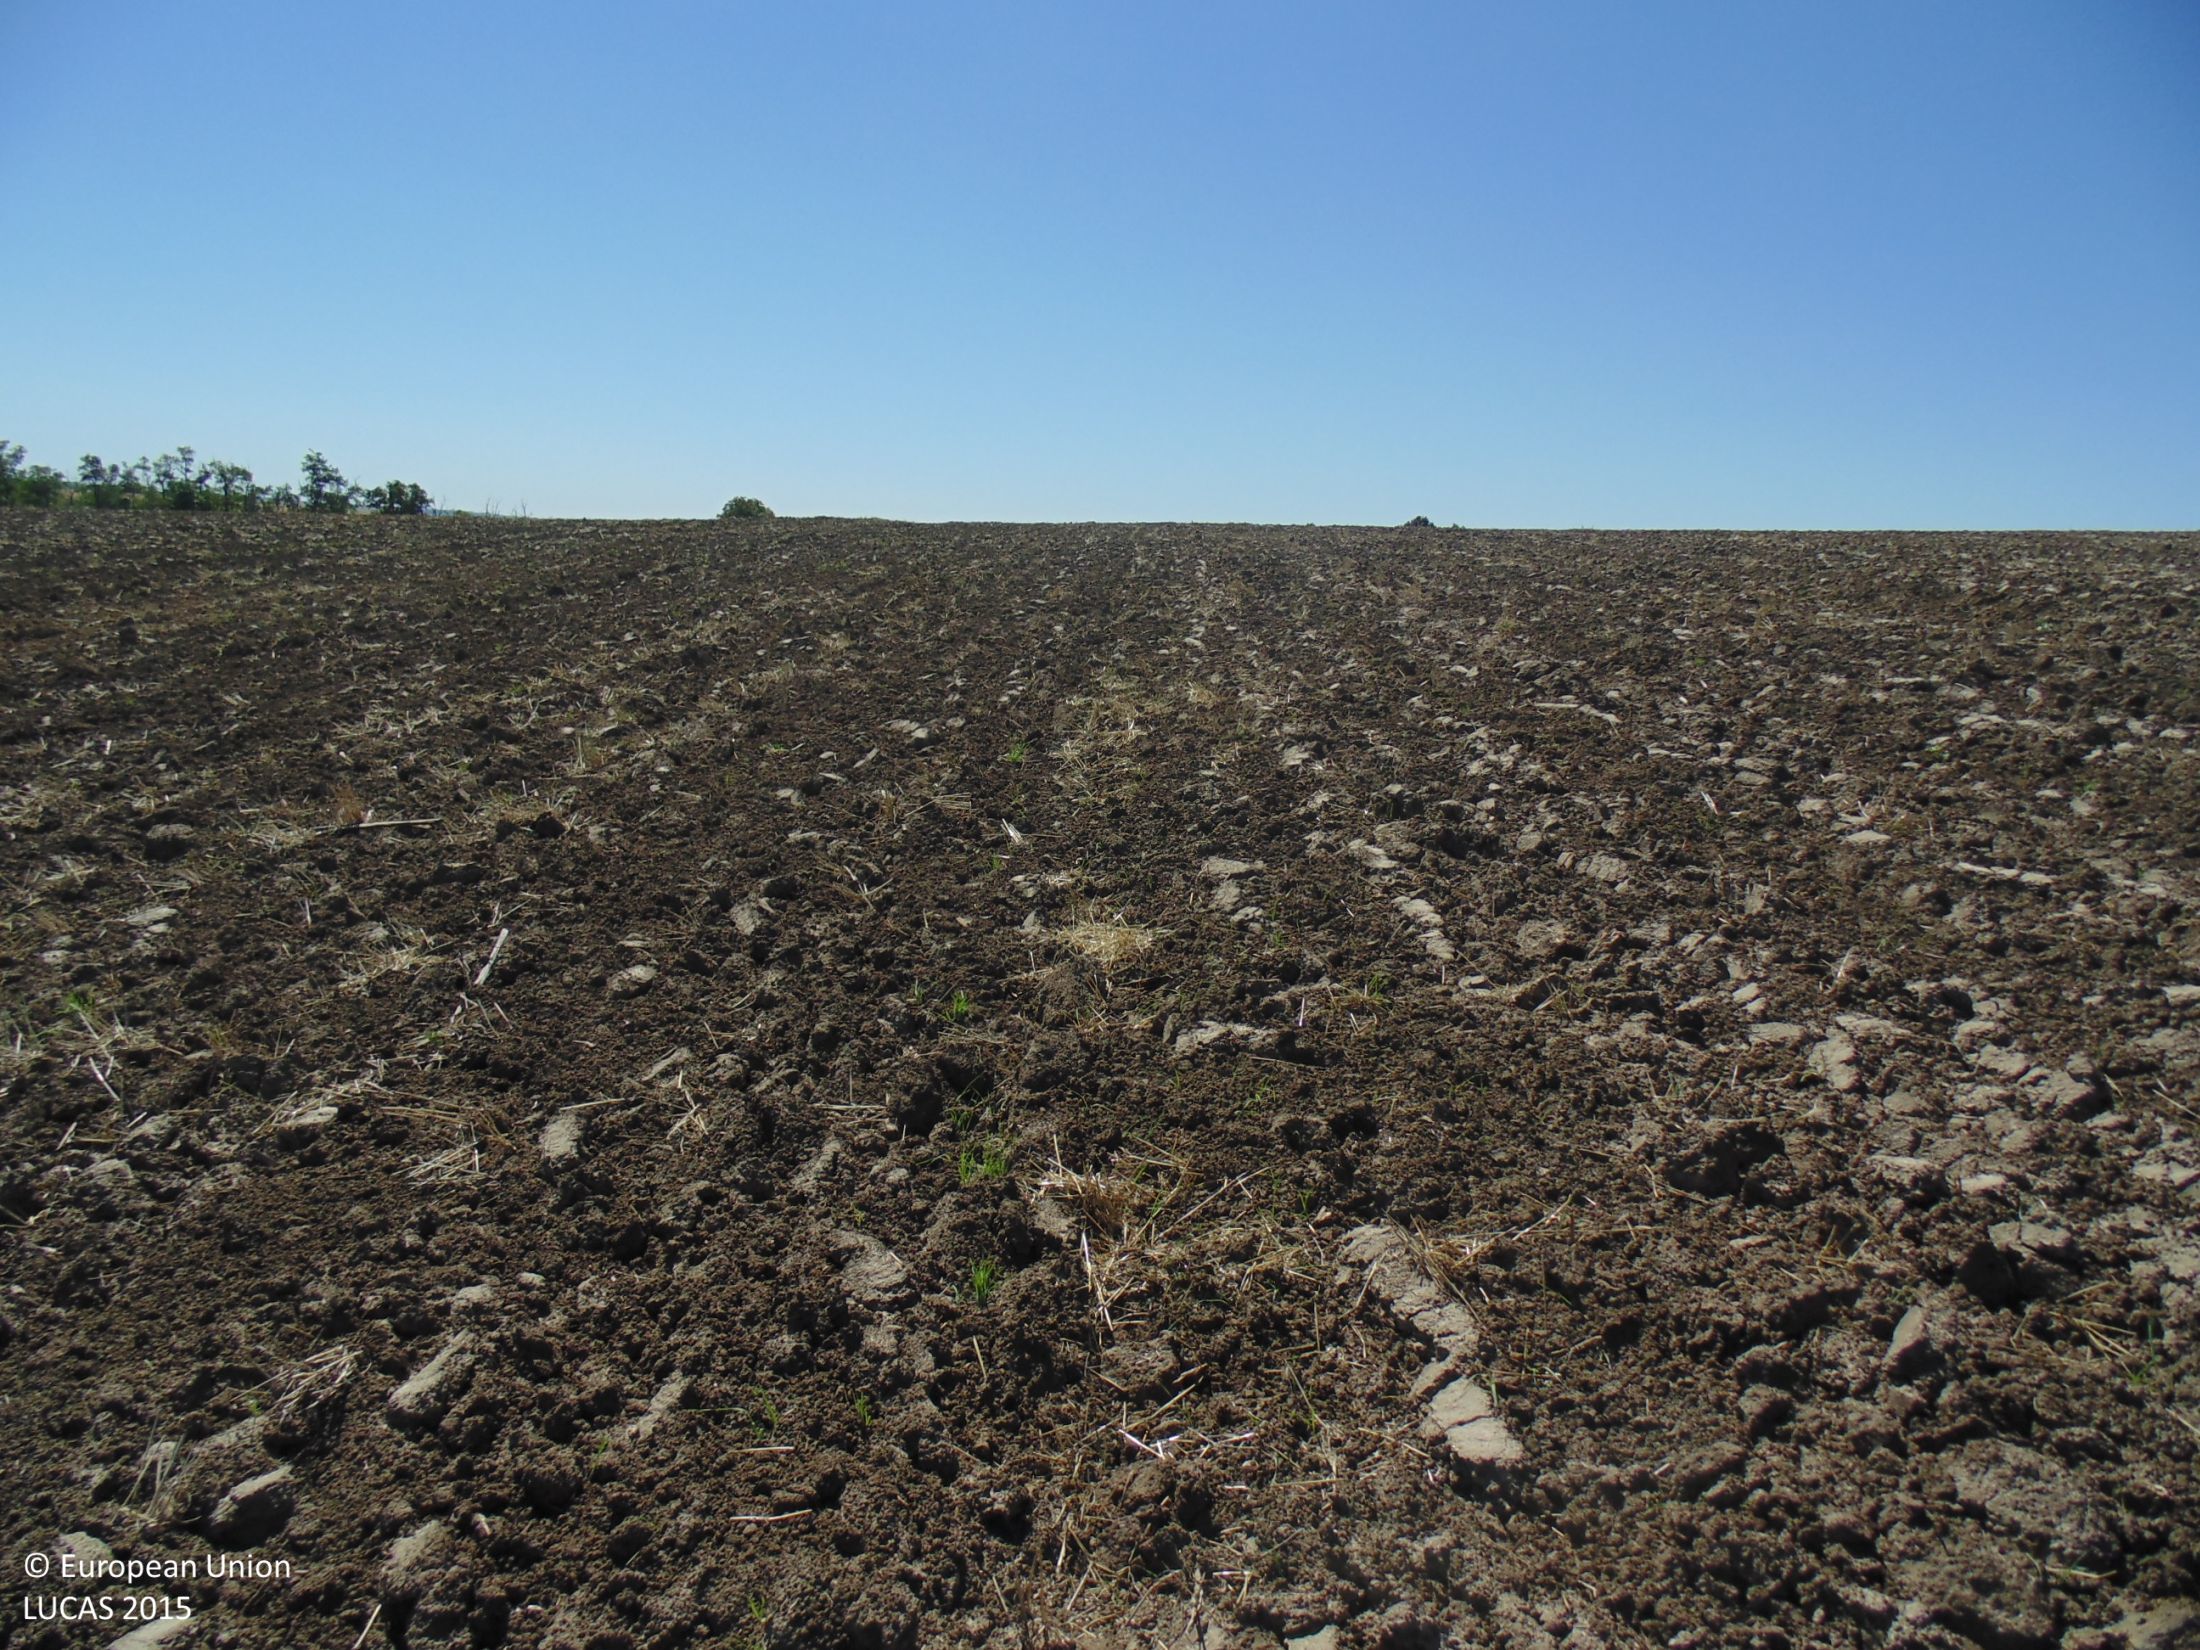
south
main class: Cropland
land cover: Common wheat
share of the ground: < 10 %
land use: Agriculture (excluding fallow land and kitchen gardens)
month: September
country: BG
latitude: 43.7580
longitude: 27.3575
